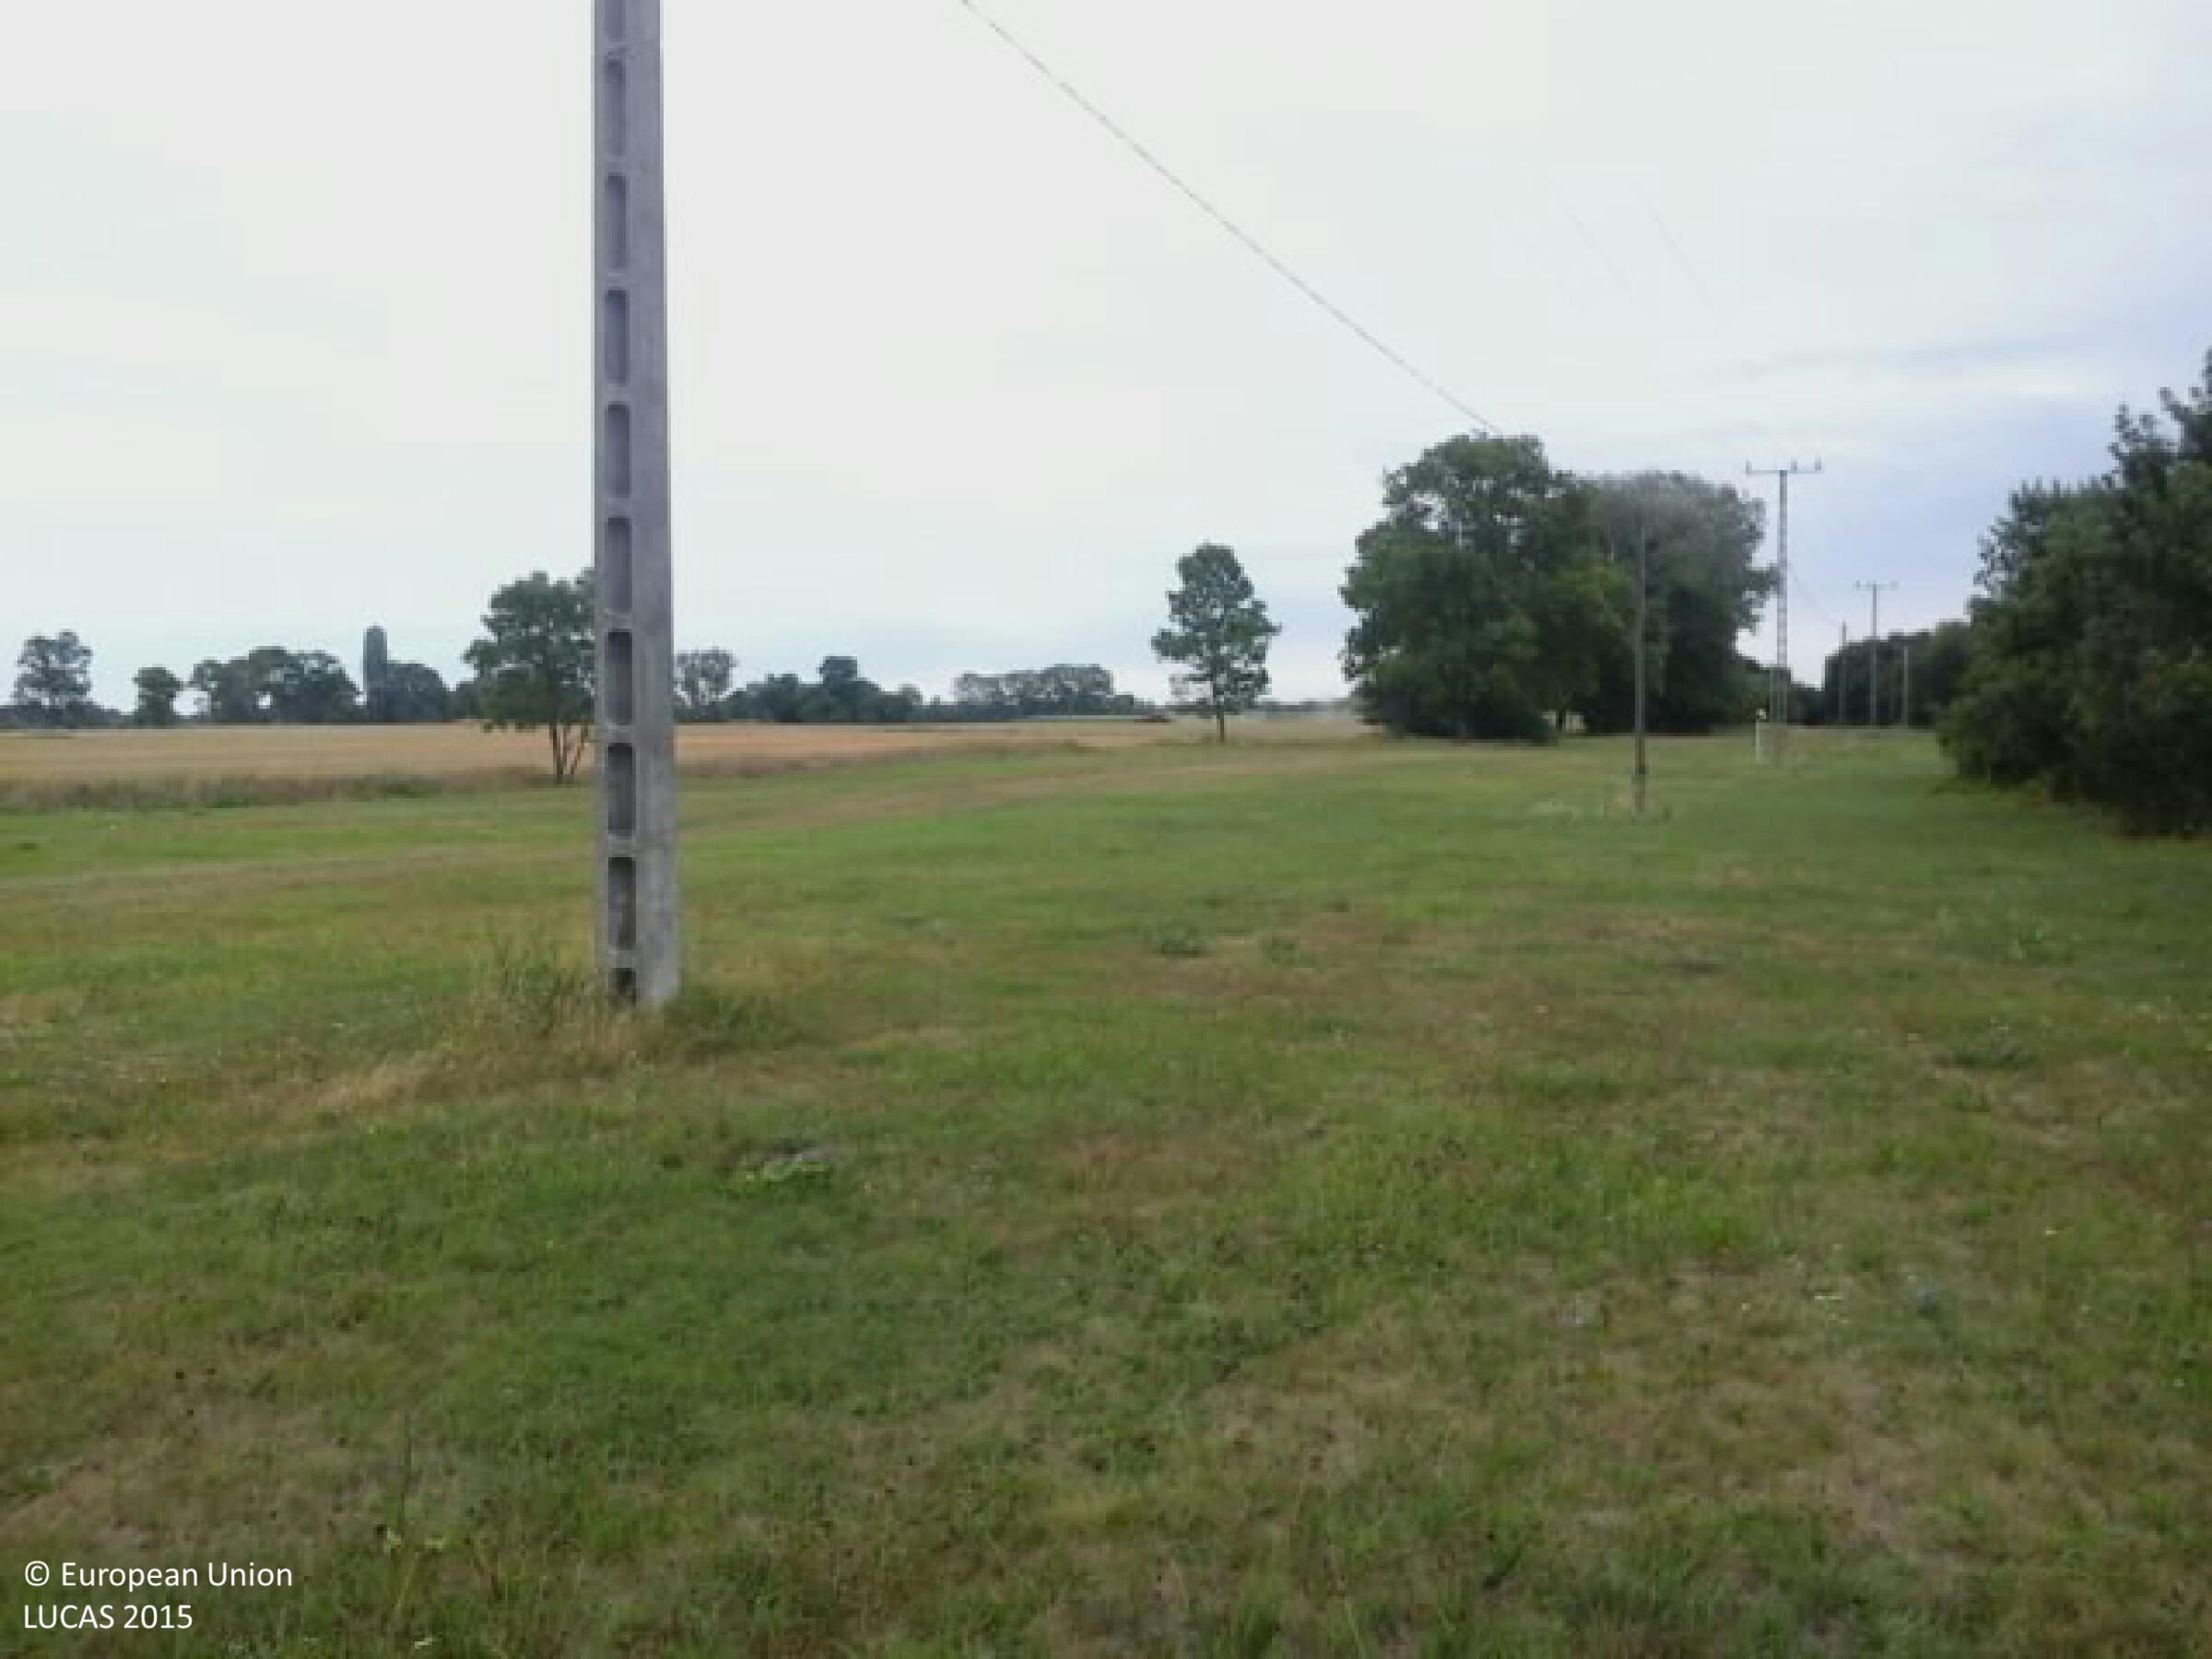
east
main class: Grassland
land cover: Grassland without tree/shrub cover
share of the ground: > 75 %
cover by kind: herbaceous plants 100 %
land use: Agriculture (excluding fallow land and kitchen gardens)
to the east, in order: Grassland without tree/shrub cover; Electric lines; Grassland without tree/shrub cover; Tracks; Grassland without tree/shrub cover; Other bare soil; Grass margins; Tracks; Grass margins; Other bare soil
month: July
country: HU
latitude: 47.0473
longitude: 19.7491
